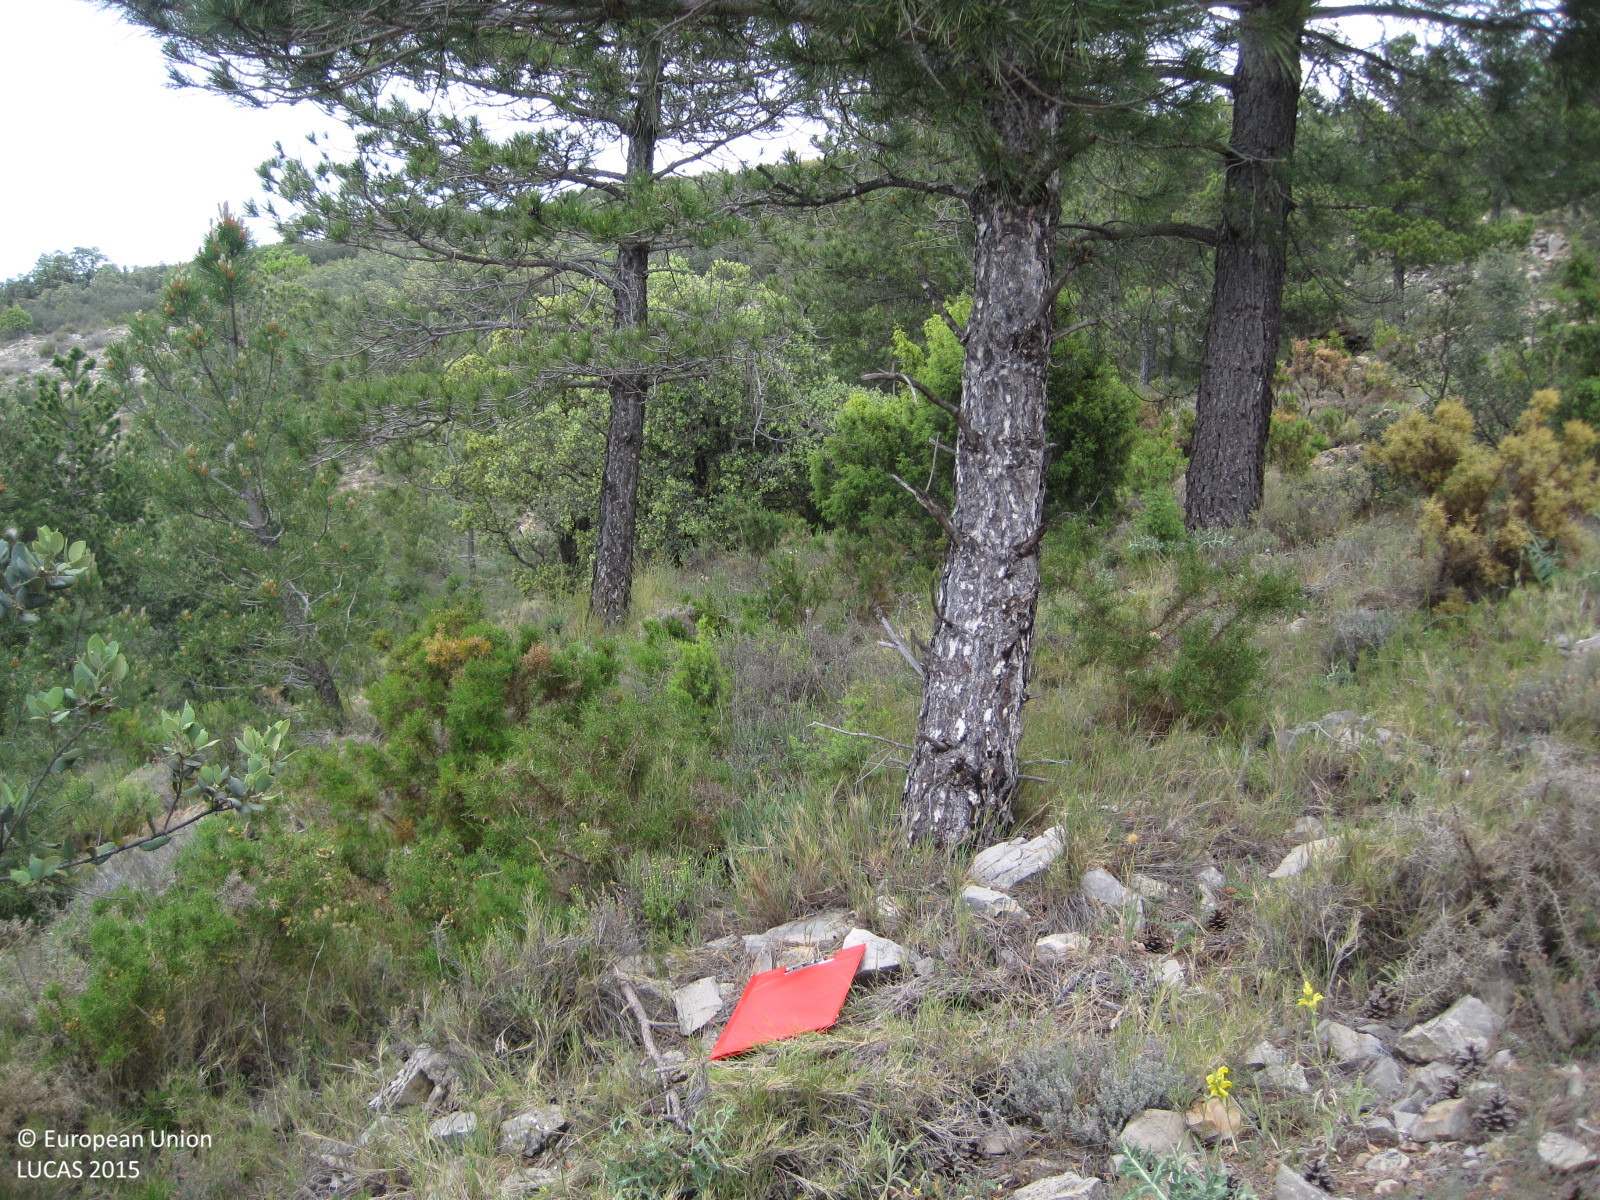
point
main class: Woodland
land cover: Pine dominated coniferous woodland
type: coniferous forest of the mediterranean region
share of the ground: 10 - 25 %
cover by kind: coniferous forest trees 40 %, shrubs 20 %, herbaceous plants 20 %, broadleaved forest trees 10 %, consolidated bare surface 10 %
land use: Forestry
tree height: > 5 m
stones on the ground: 25 - 50 %
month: May
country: ES
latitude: 39.8783
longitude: -0.7254
